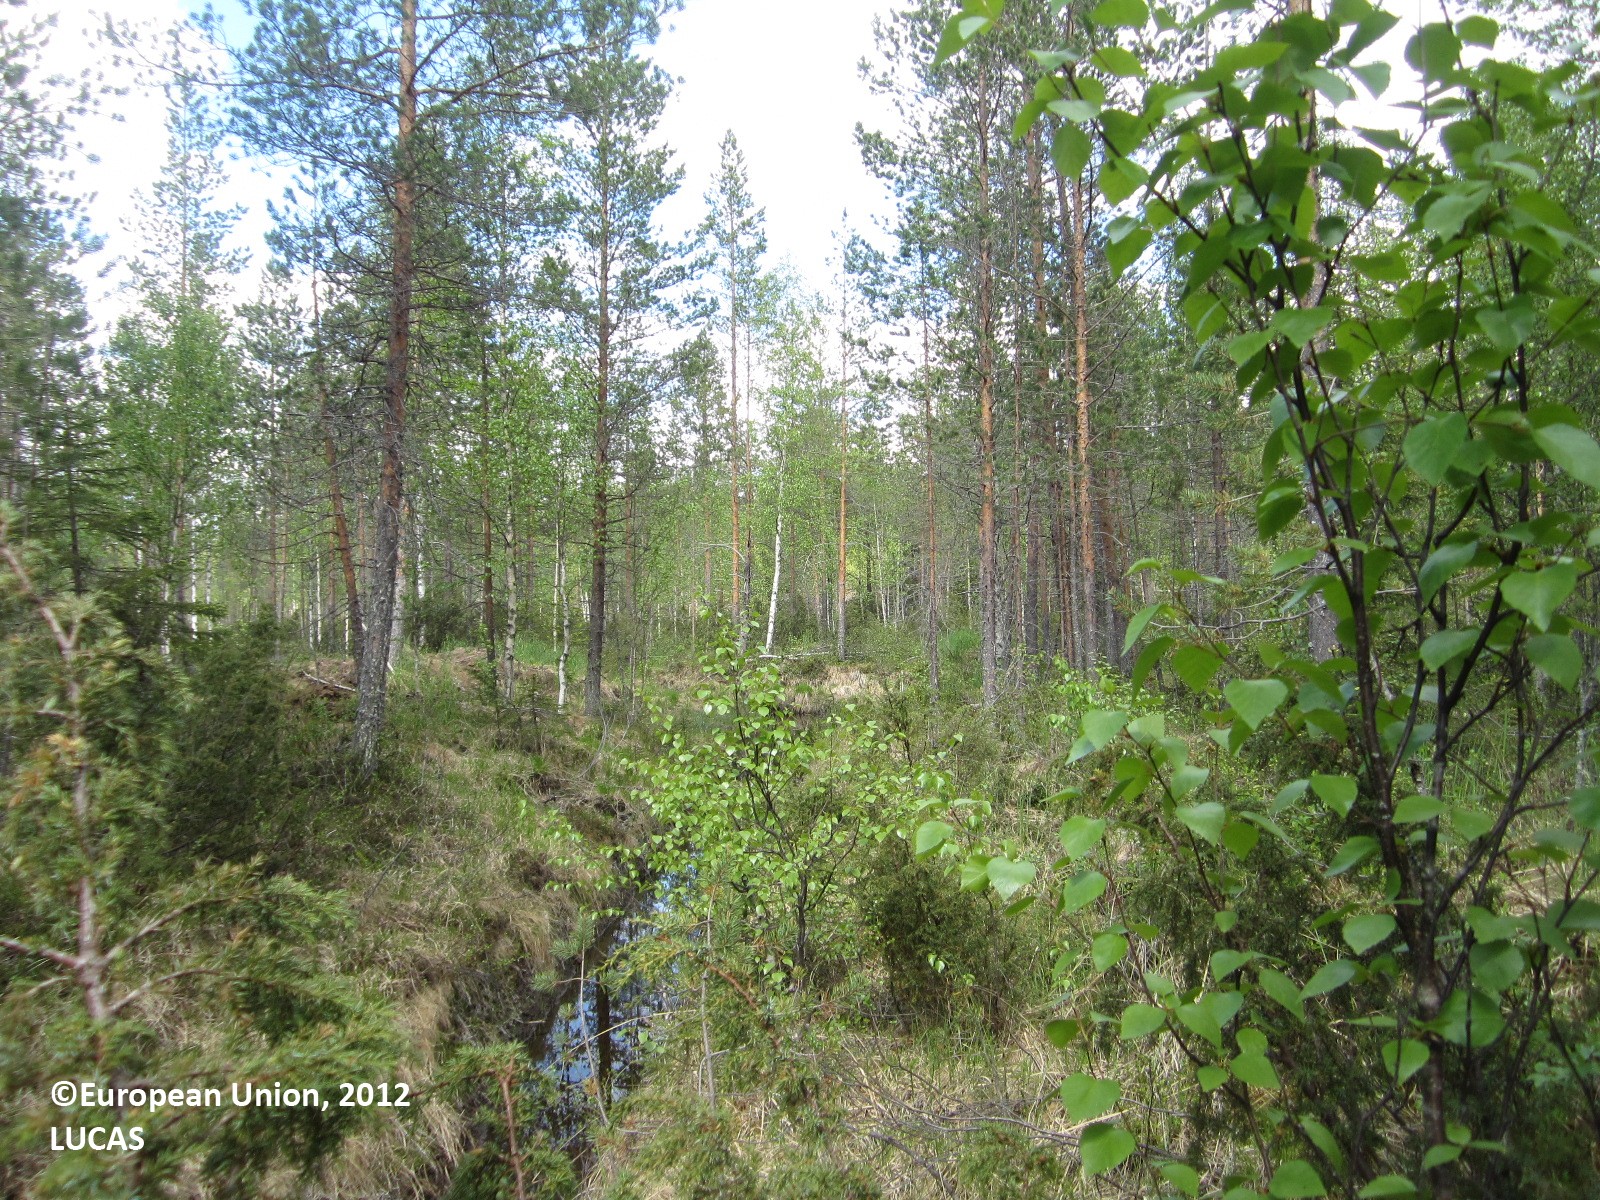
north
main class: Woodland
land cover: Other coniferous woodland
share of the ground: 50 - 75 %
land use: Forestry
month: June
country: FI
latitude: 64.5903
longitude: 28.7527
